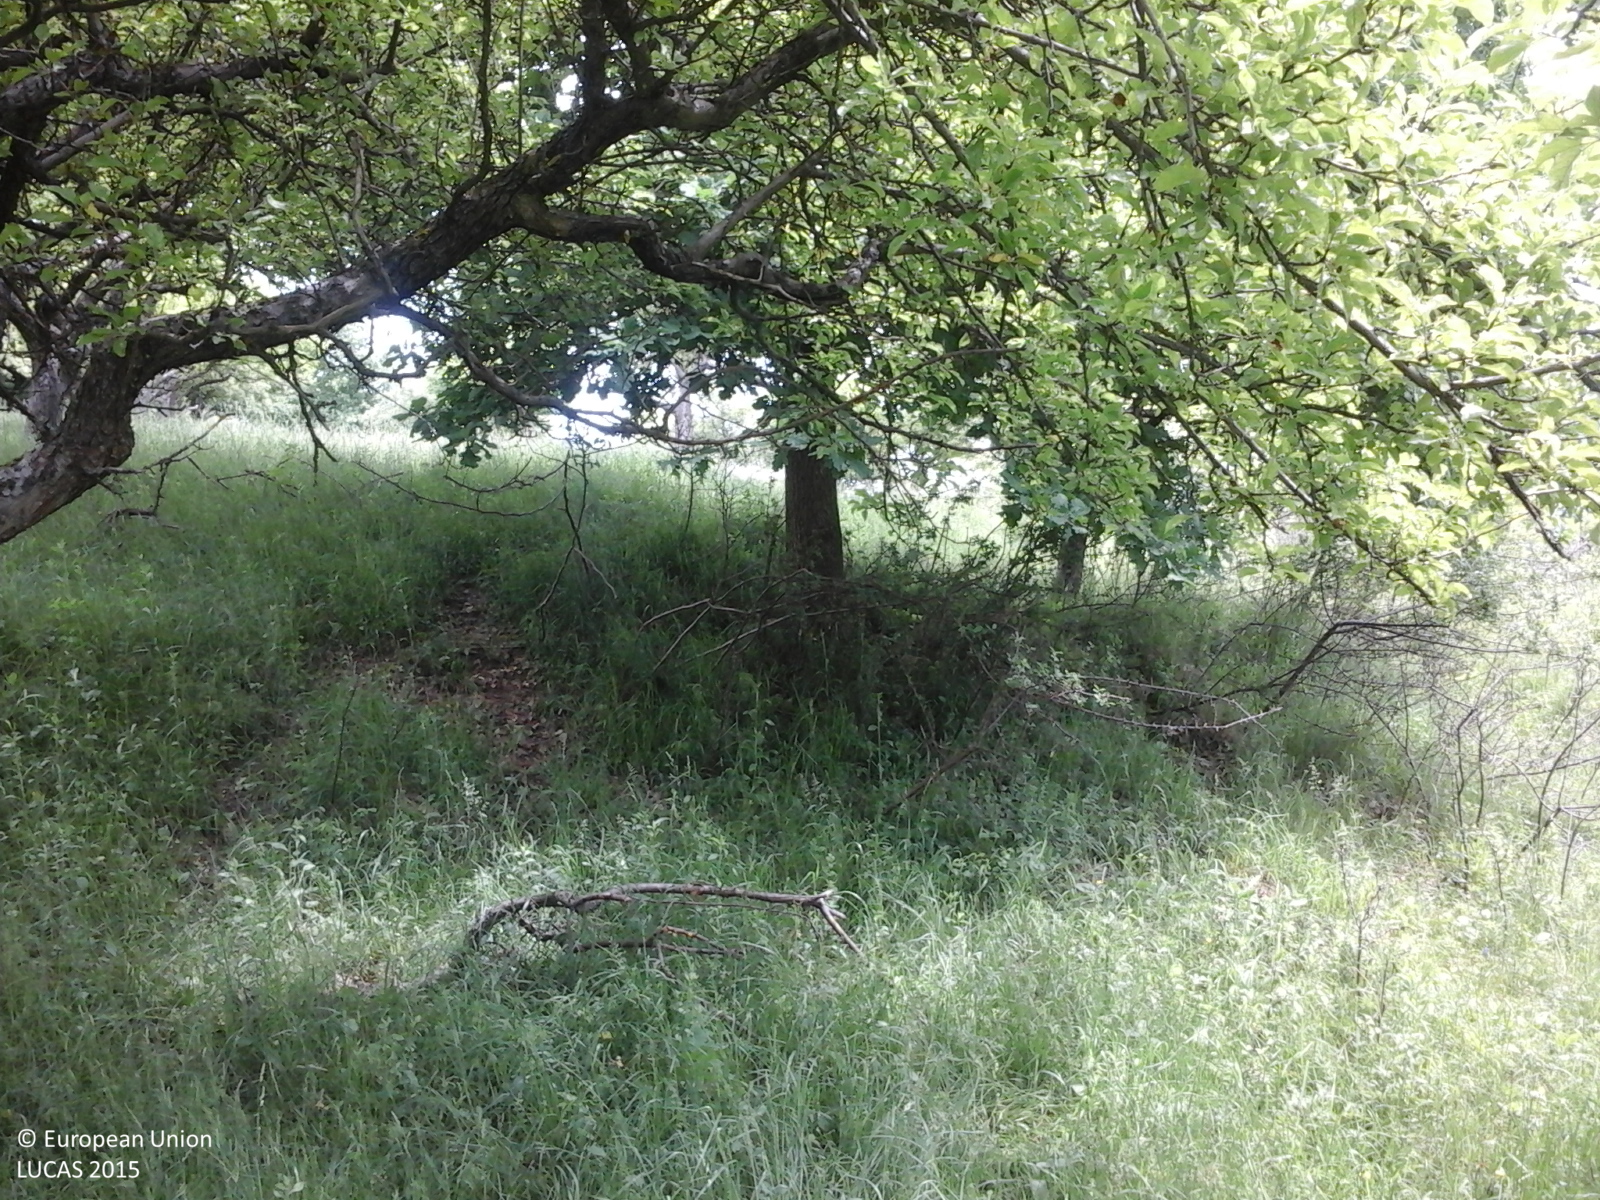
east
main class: Cropland
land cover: Apple fruit
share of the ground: > 75 %
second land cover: Grassland without tree/shrub cover
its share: 50 - 75 %
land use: Agriculture (excluding fallow land and kitchen gardens)
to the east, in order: Apple fruit; Grassland without tree/shrub cover; Broadleaved woodland; Grassland with sparse tree/shrub cover; Abandoned hedges; Grassland without tree/shrub cover; Tracks; Apple fruit
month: May
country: RO
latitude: 45.2396
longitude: 26.2834
